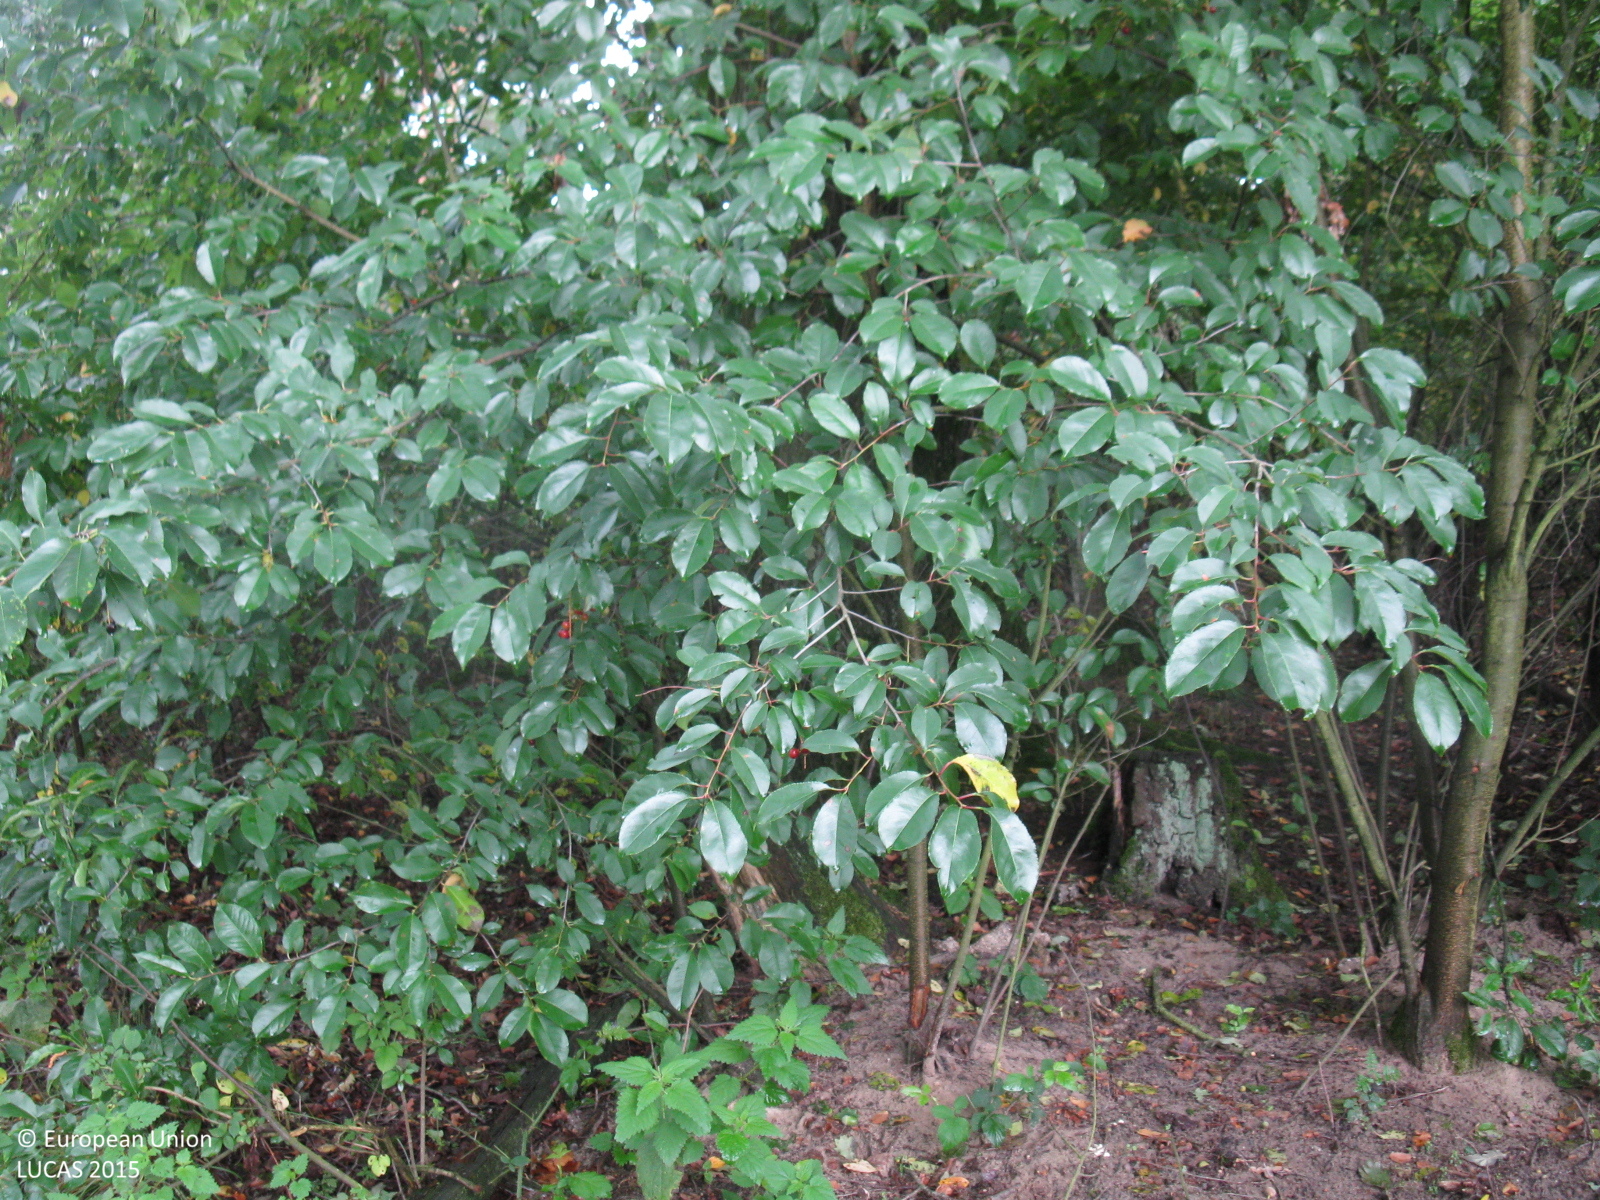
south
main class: Cropland
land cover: Maize
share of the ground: > 75 %
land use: Agriculture (excluding fallow land and kitchen gardens)
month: August
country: DE
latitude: 51.7266
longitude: 6.9452
